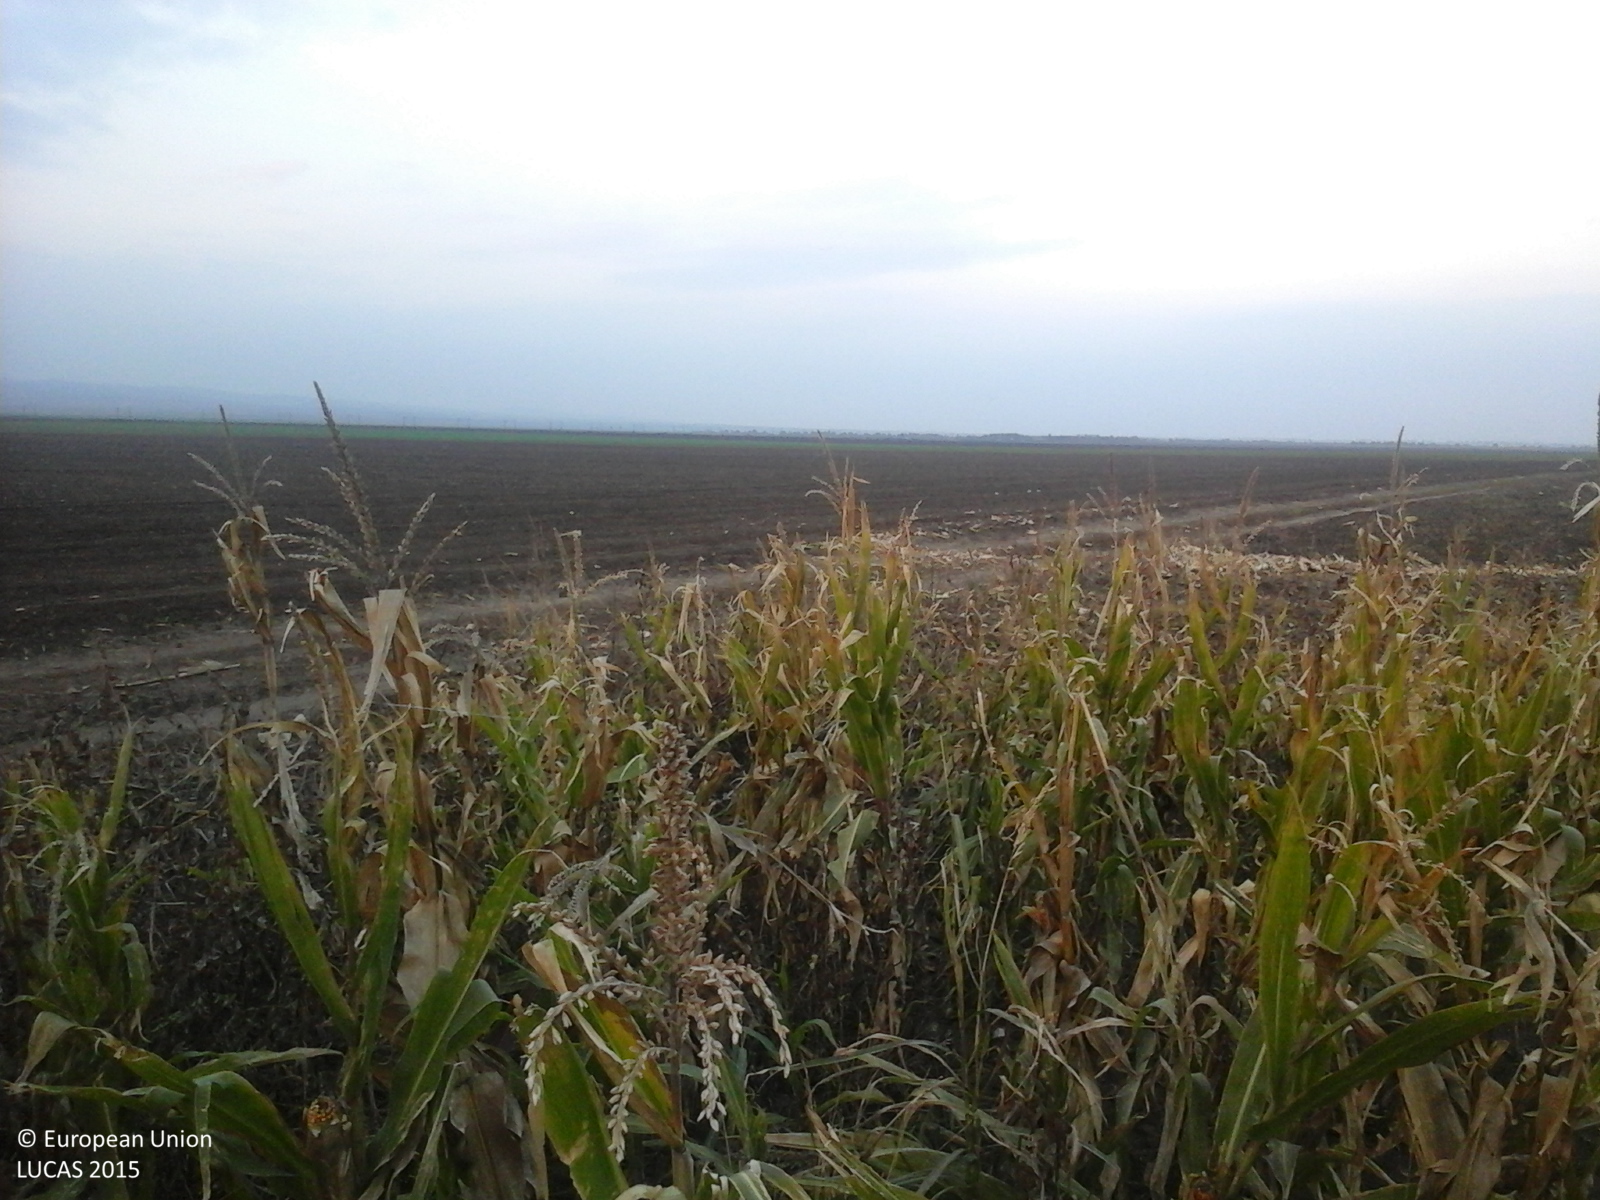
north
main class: Cropland
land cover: Maize
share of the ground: > 75 %
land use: Agriculture (excluding fallow land and kitchen gardens)
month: October
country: RO
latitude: 45.2542
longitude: 26.9947
